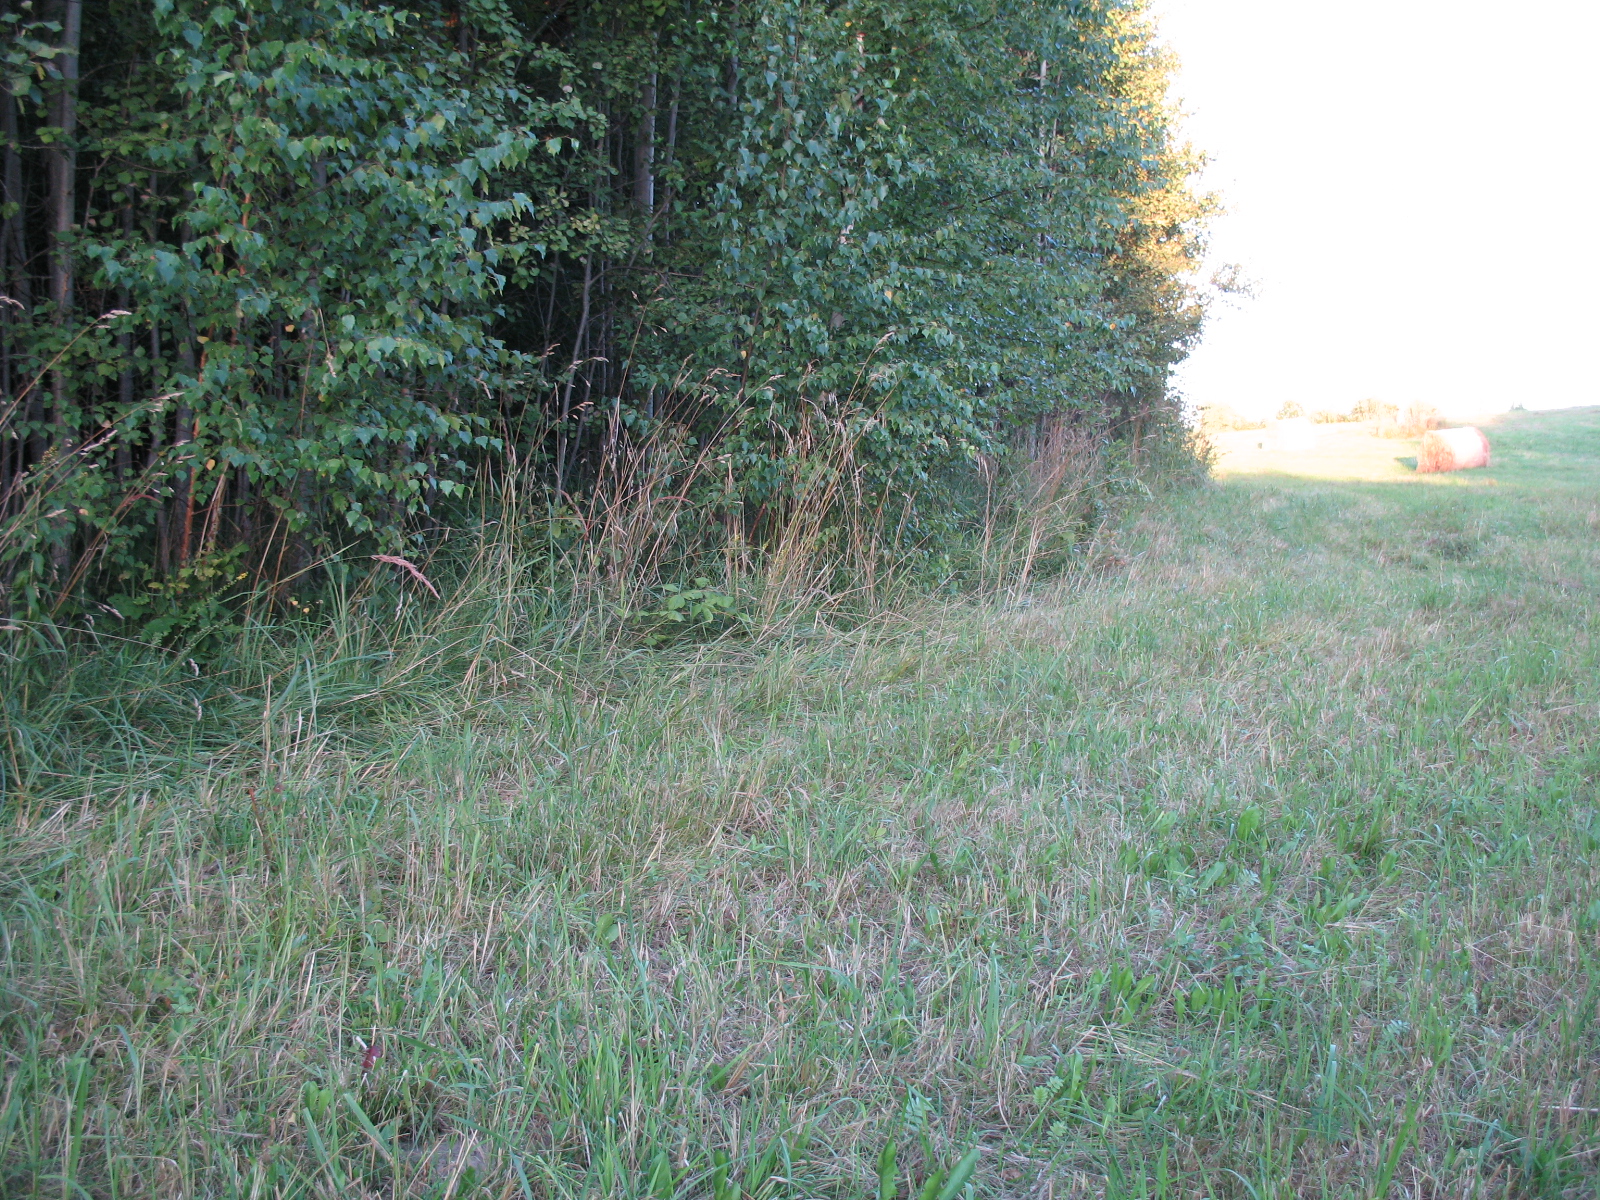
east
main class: Grassland
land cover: Grassland without tree/shrub cover
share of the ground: > 75 %
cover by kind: herbaceous plants 95 %, unconsolidated bare surface 5 %
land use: Agriculture (excluding fallow land and kitchen gardens)
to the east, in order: Grassland without tree/shrub cover; Broadleaved woodland; Grassland without tree/shrub cover; Broadleaved woodland; Shrubland with sparse tree cover; Electric lines; Broadleaved woodland; Grassland with sparse tree/shrub cover; Spontaneously vegetated surfaces; Broadleaved woodland; Ditches and canals; Broadleaved woodland
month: August
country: LV
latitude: 56.5925
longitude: 25.6765
